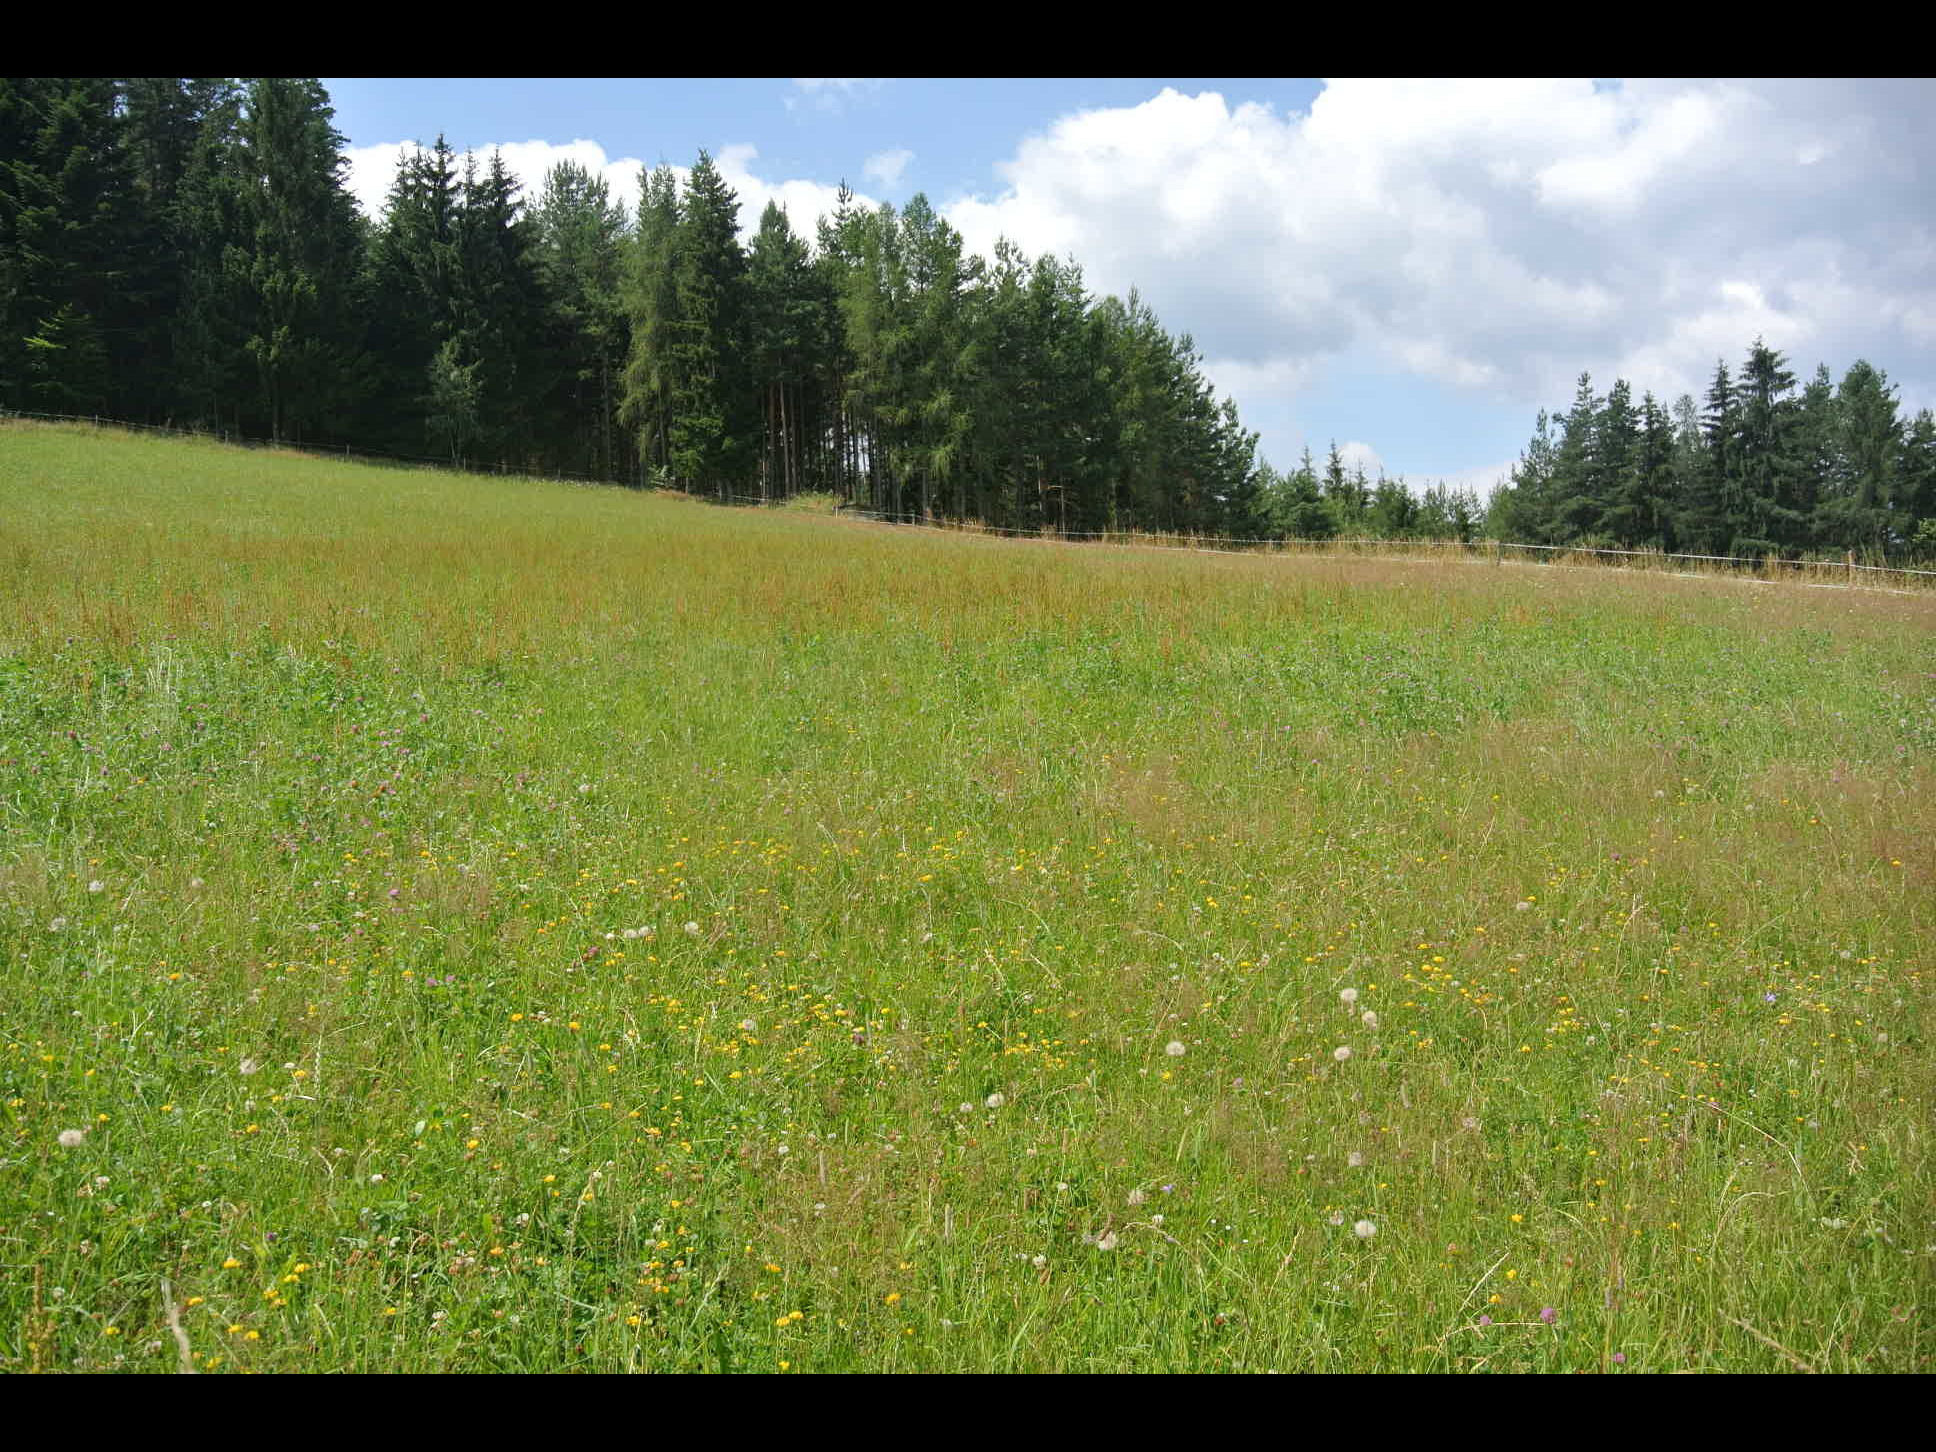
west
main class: Cropland
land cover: Temporary grasslands
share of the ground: > 75 %
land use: Agriculture (excluding fallow land and kitchen gardens)
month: July
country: AT
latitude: 47.6447
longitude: 16.0062
